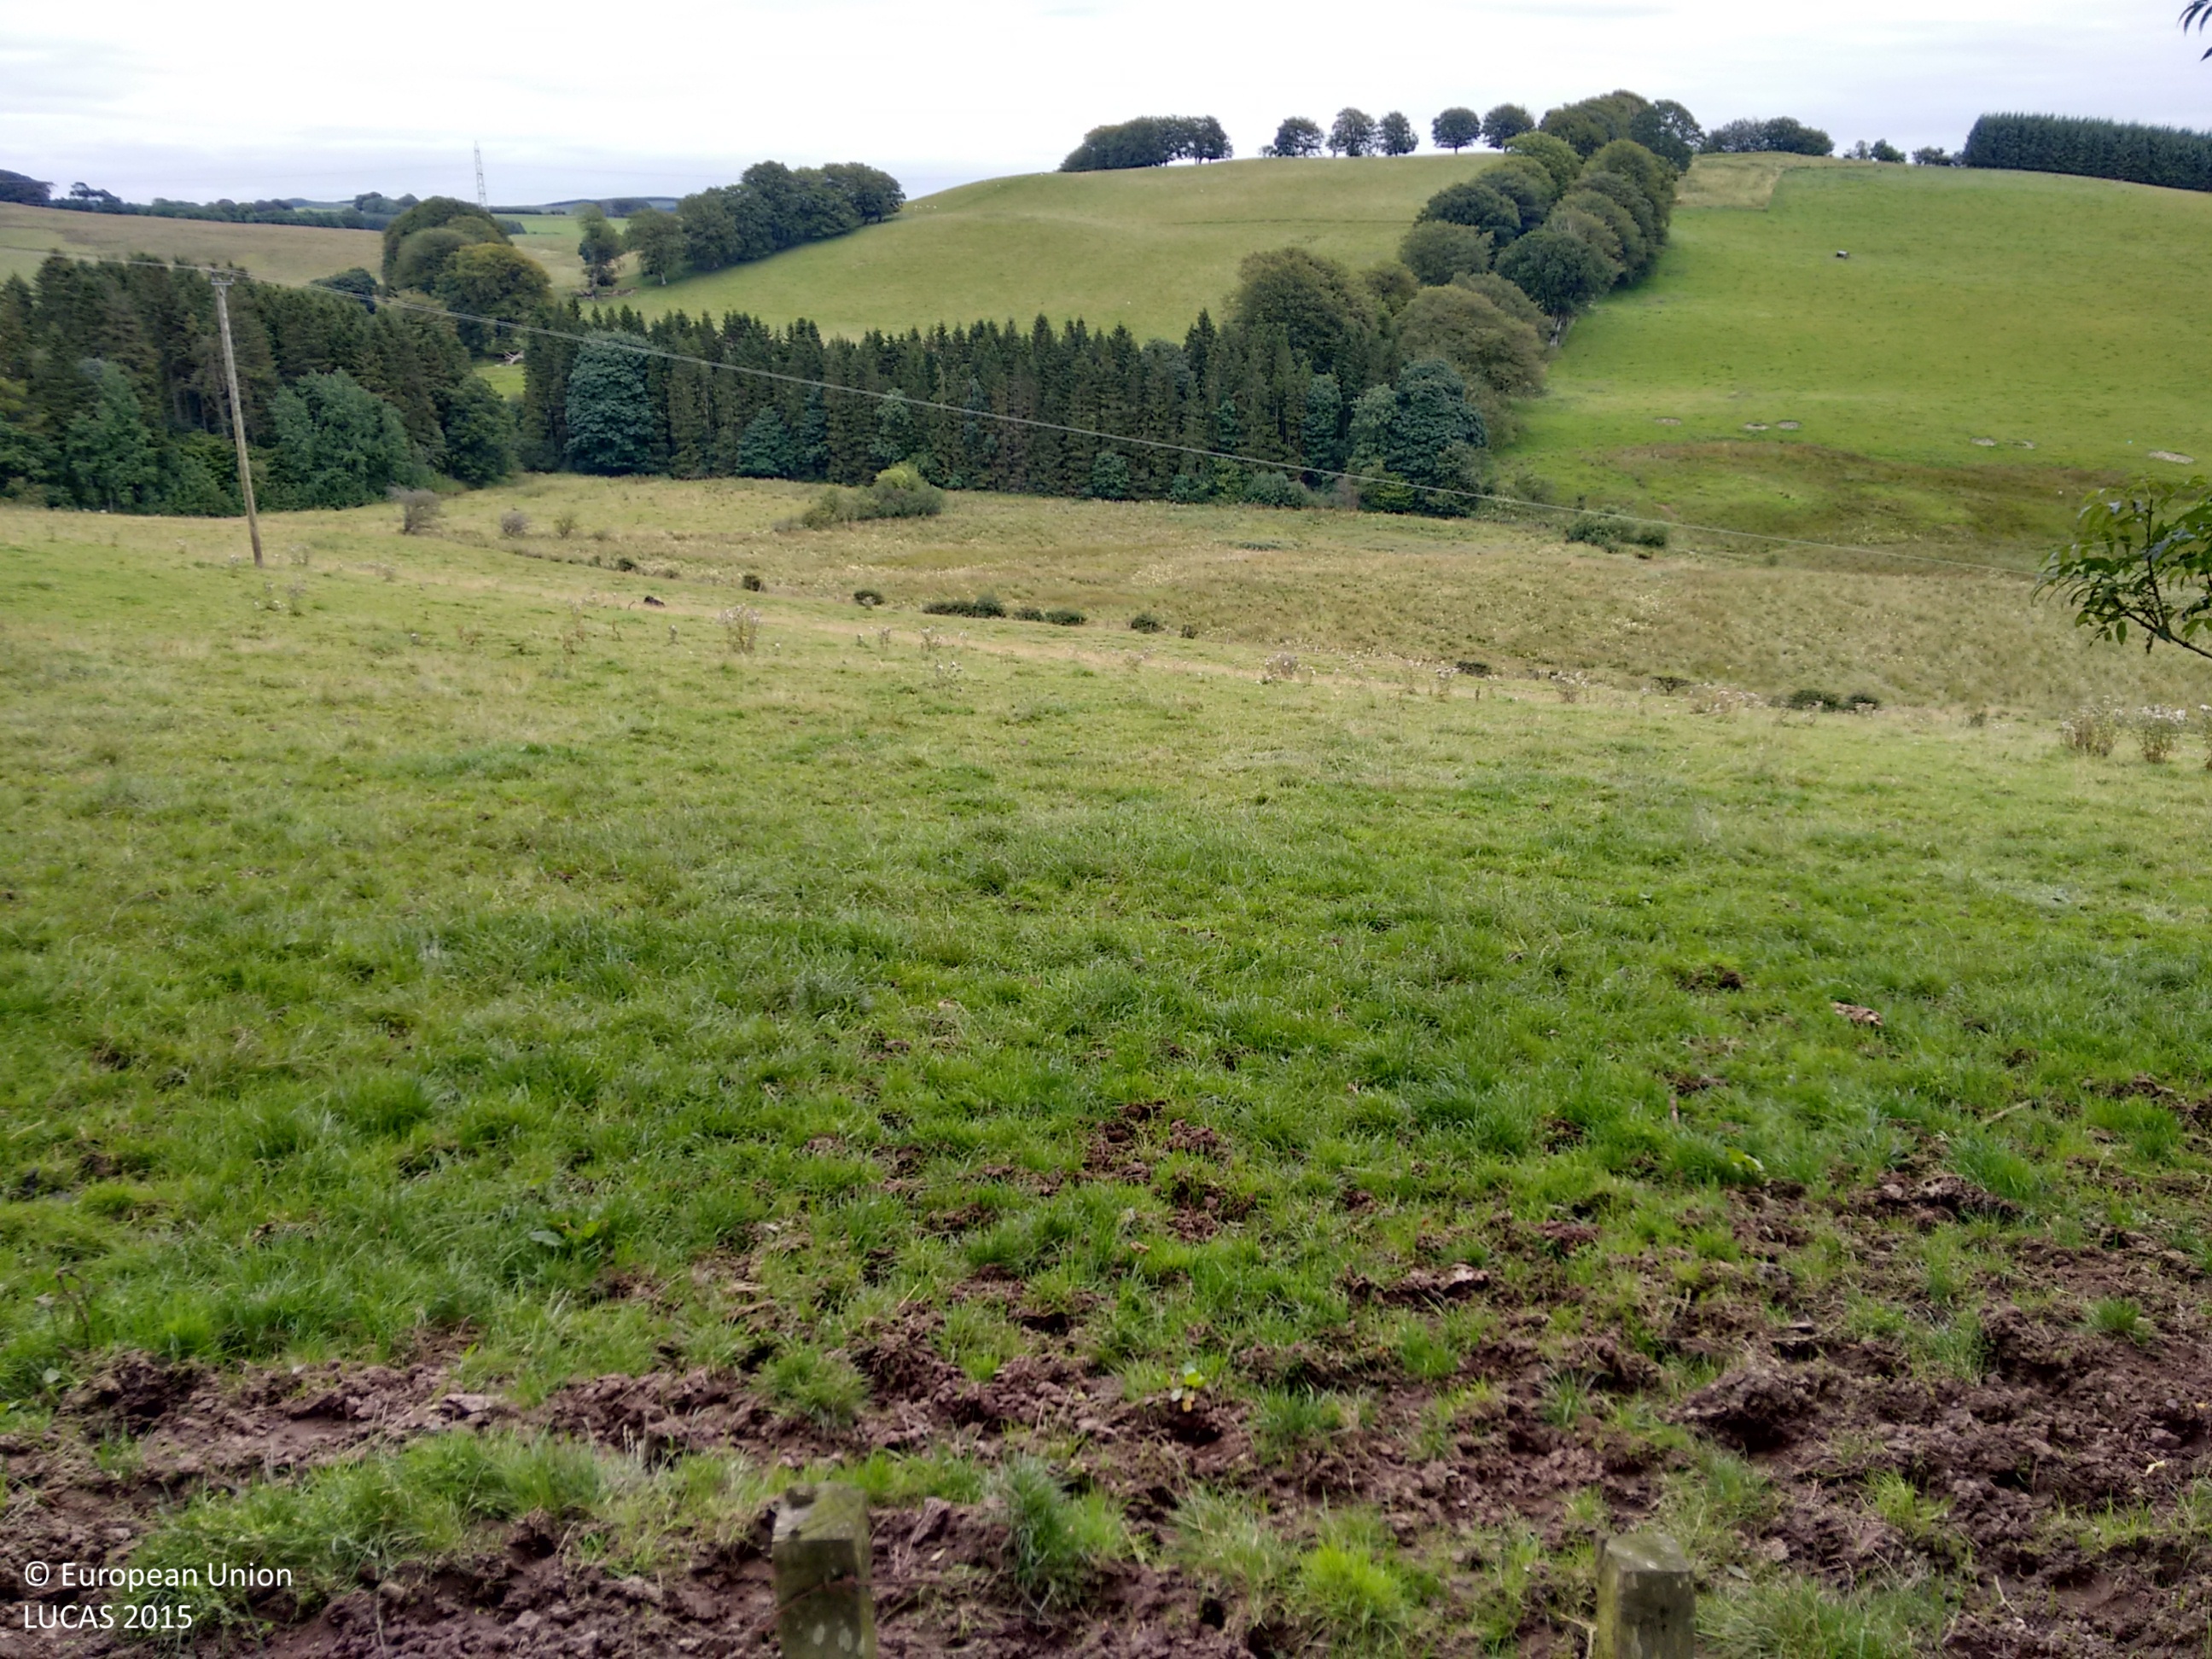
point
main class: Grassland
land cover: Grassland without tree/shrub cover
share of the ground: > 75 %
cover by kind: herbaceous plants 100 %
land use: Agriculture (excluding fallow land and kitchen gardens)
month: August
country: GB
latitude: 55.1939
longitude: -3.3512
